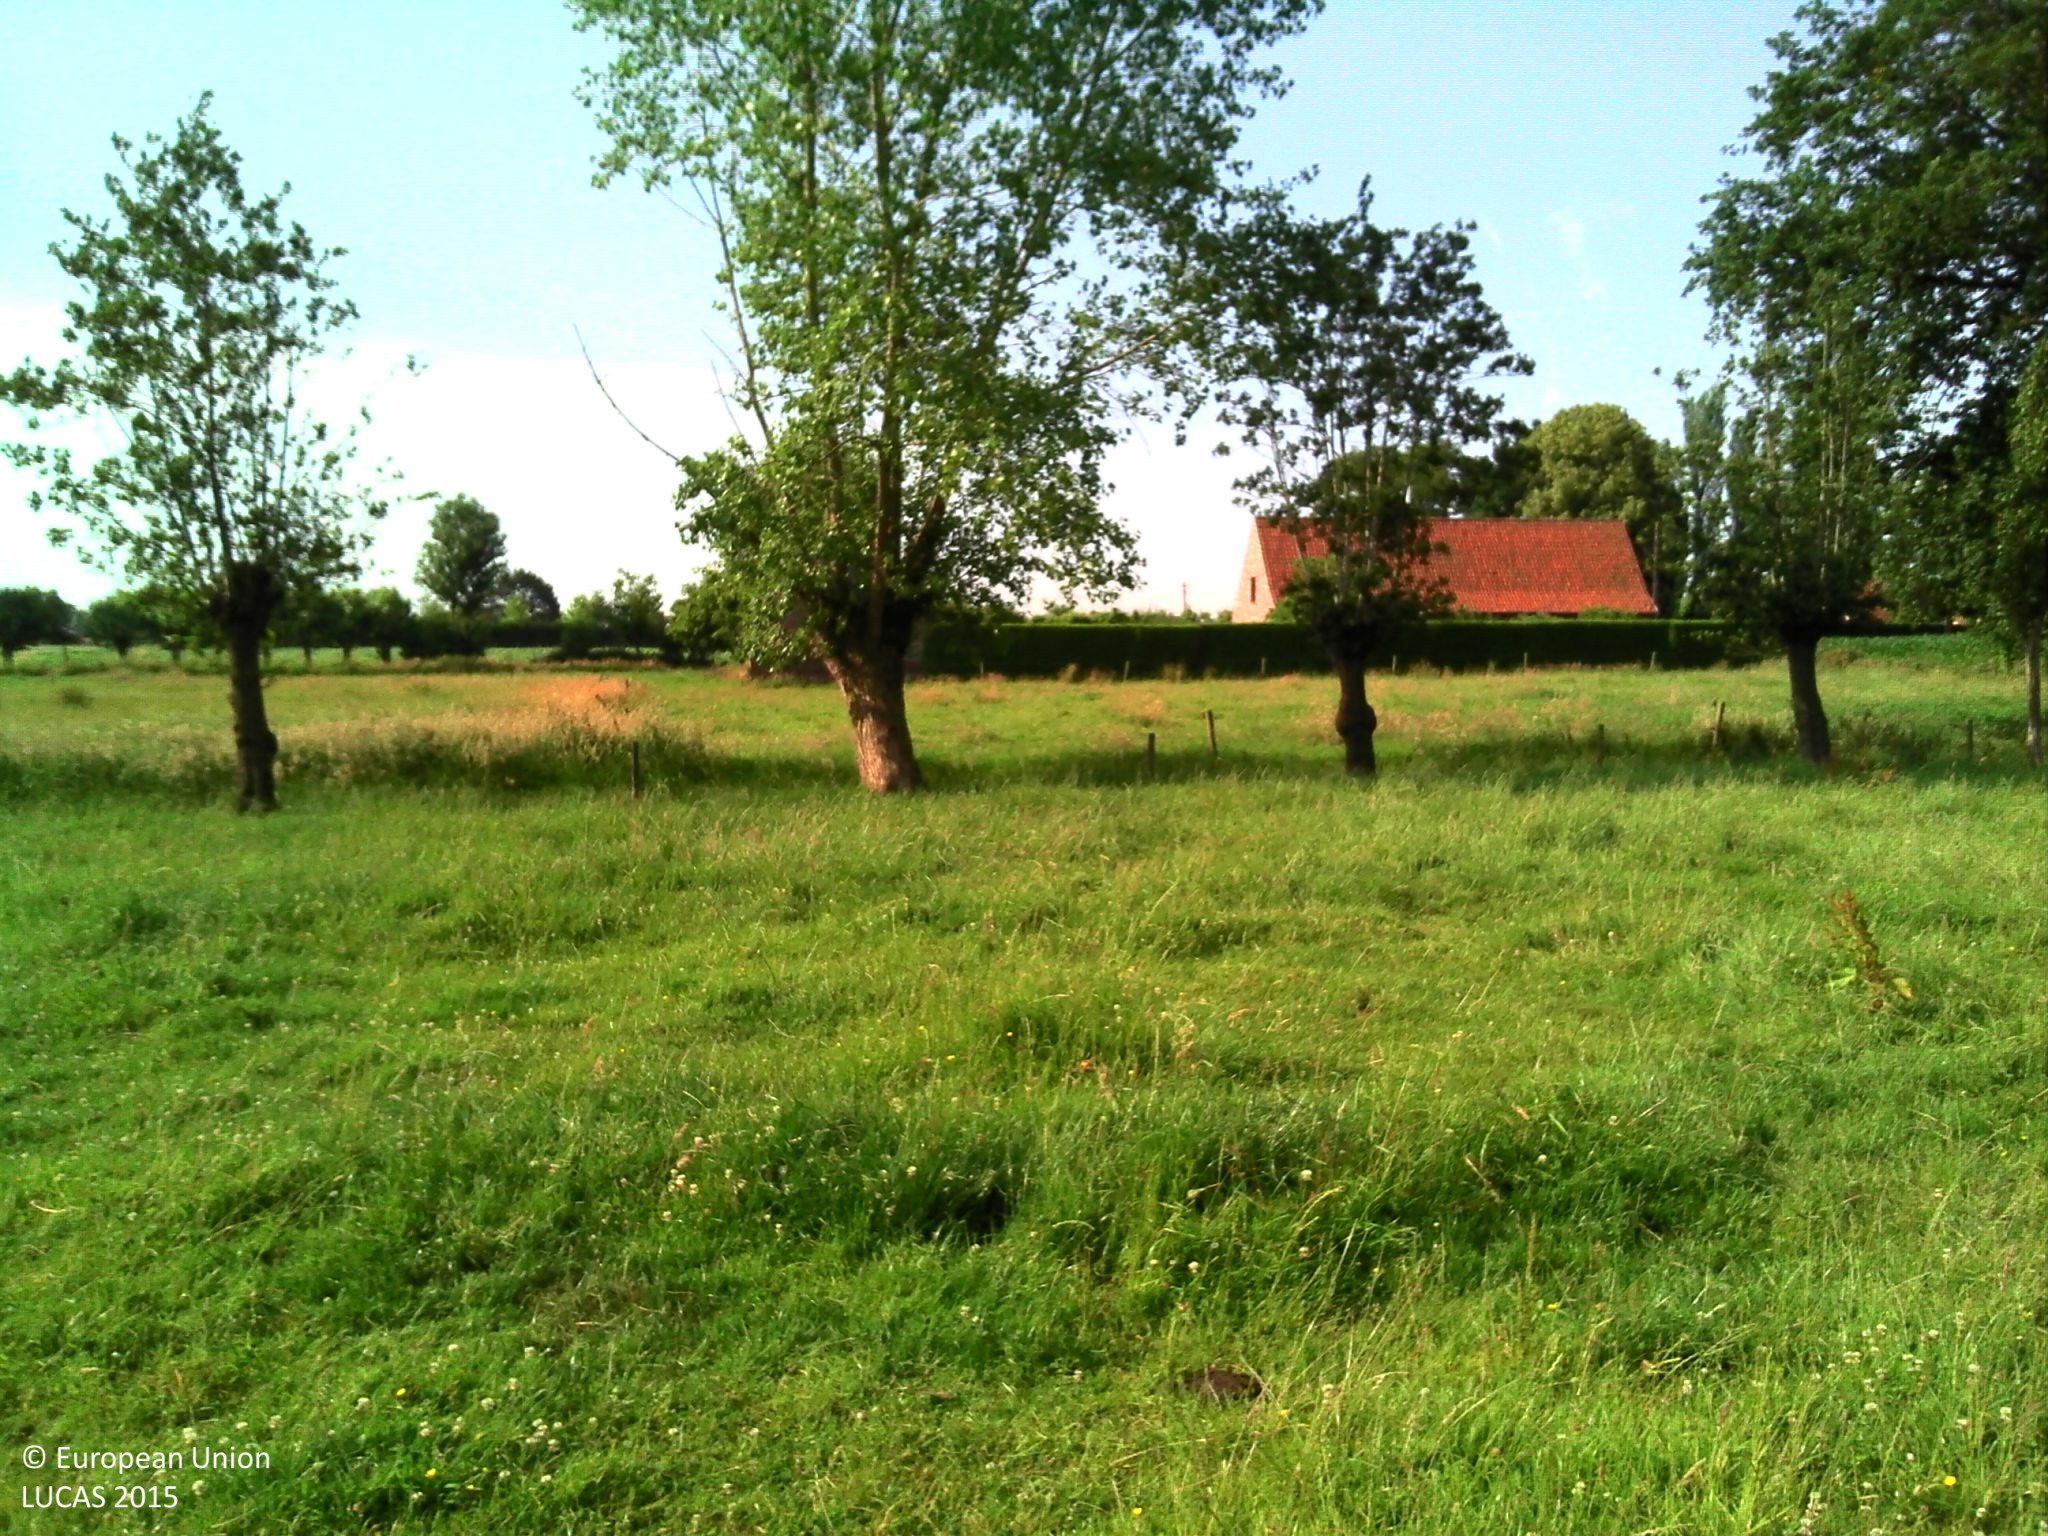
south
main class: Grassland
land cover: Grassland without tree/shrub cover
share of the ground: > 75 %
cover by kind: herbaceous plants 100 %
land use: Agriculture (excluding fallow land and kitchen gardens)
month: July
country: BE
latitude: 51.0777
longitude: 3.4403
